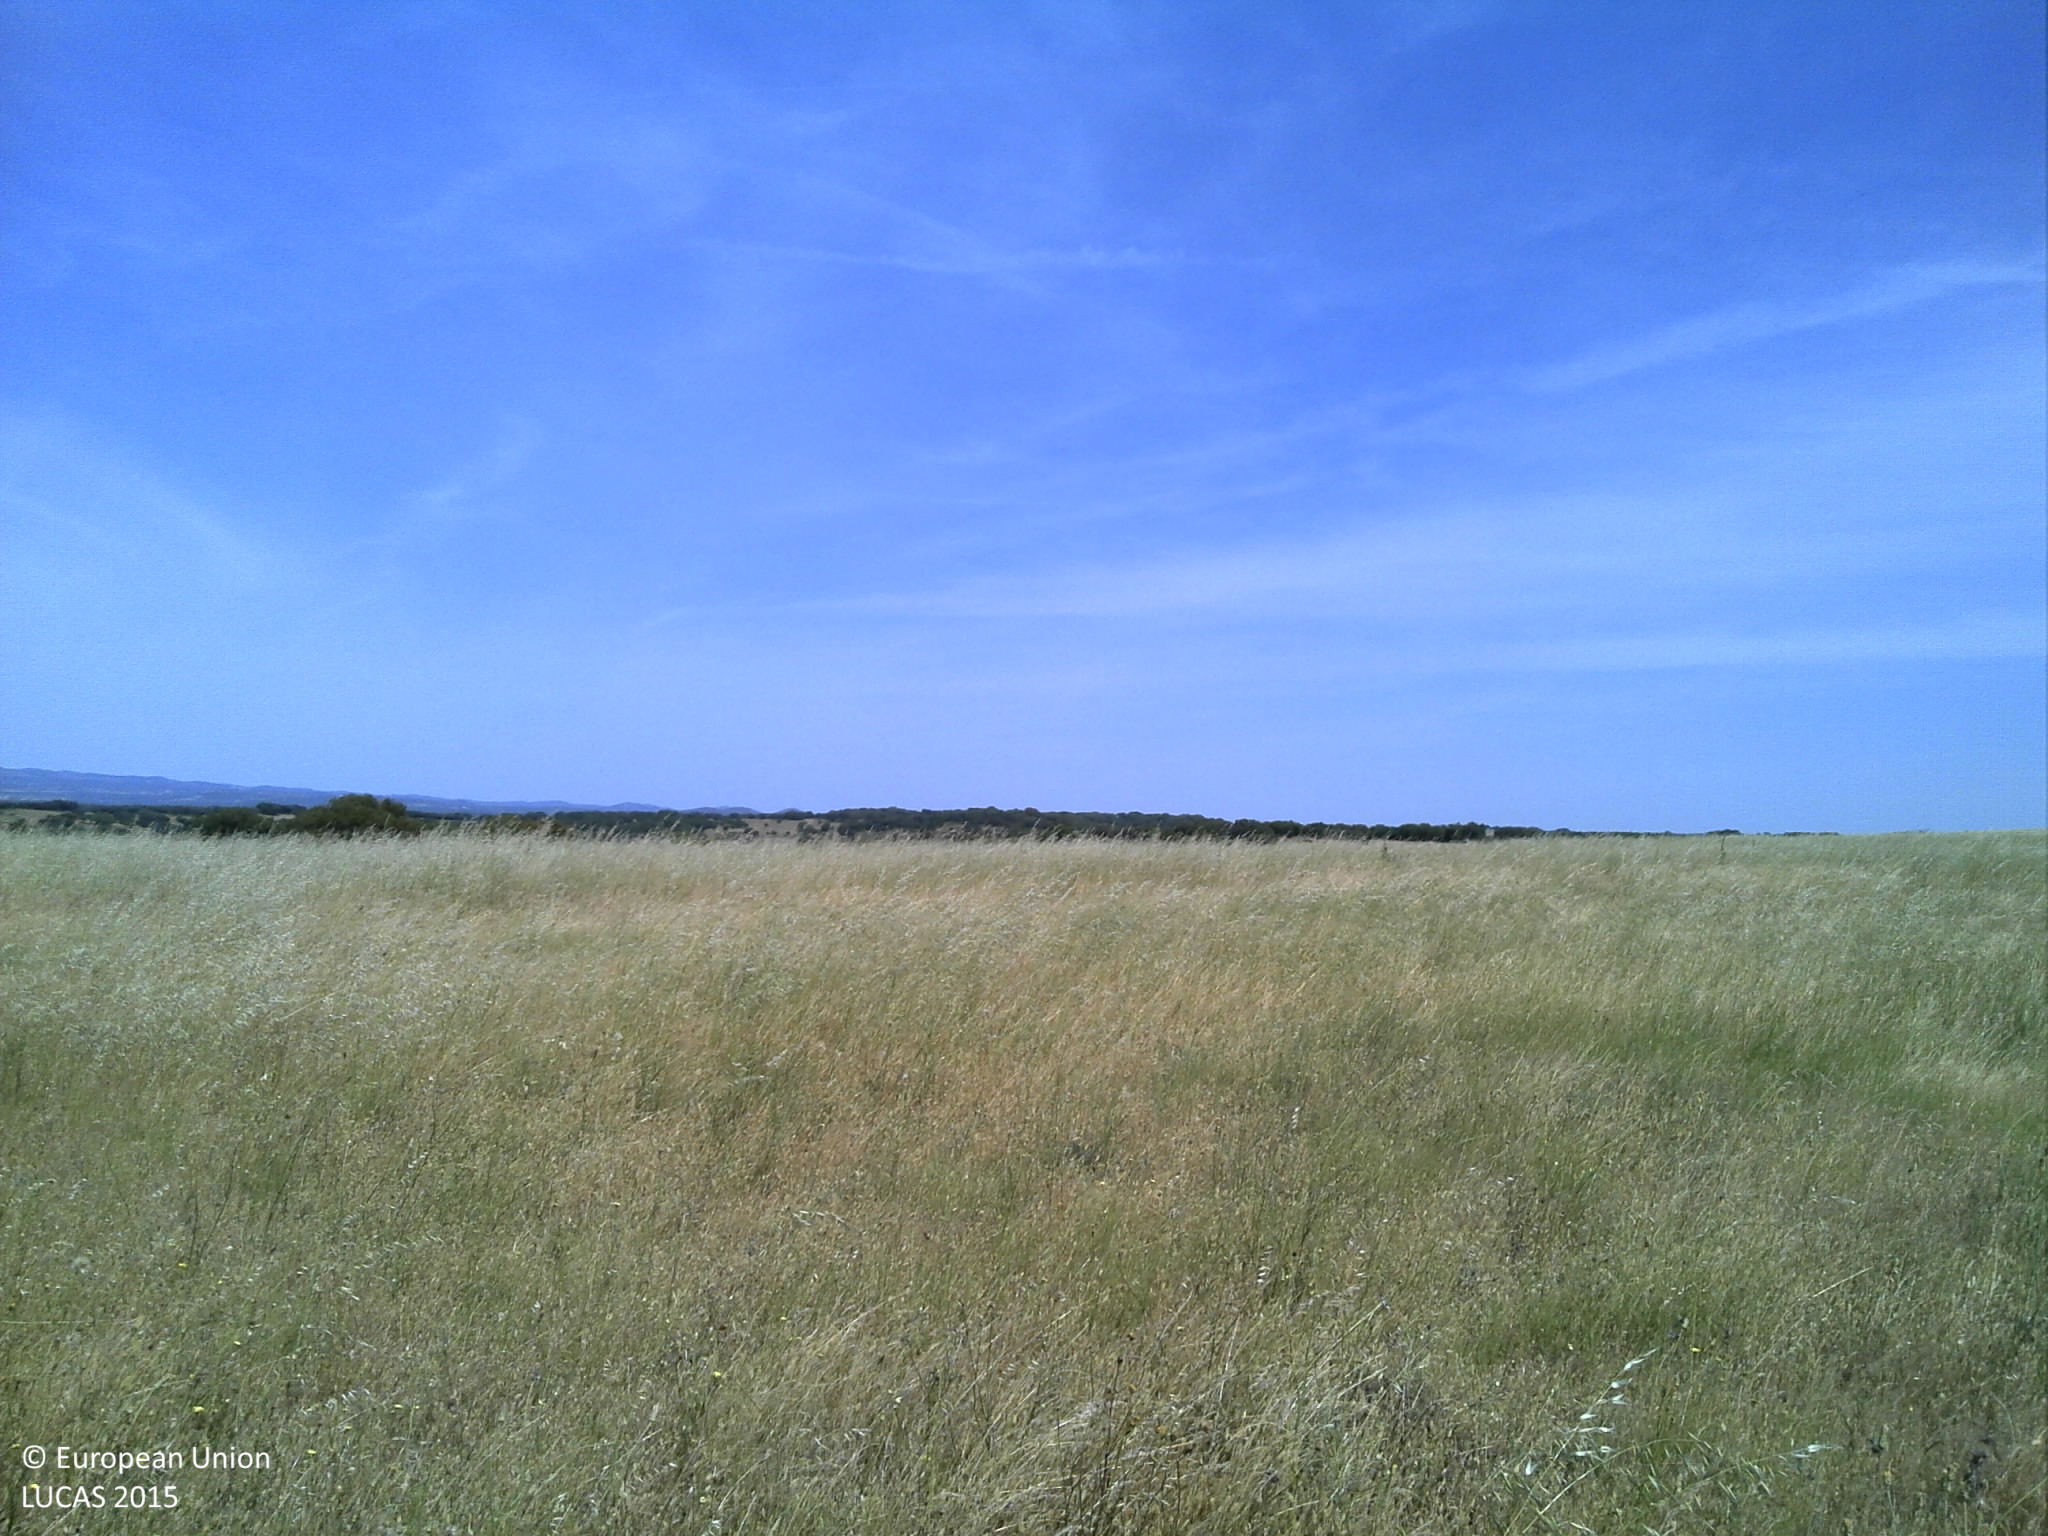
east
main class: Grassland
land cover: Grassland without tree/shrub cover
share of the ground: > 75 %
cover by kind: herbaceous plants 90 %, unconsolidated bare surface 10 %
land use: Agriculture (excluding fallow land and kitchen gardens)
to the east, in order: Grassland without tree/shrub cover
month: May
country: PT
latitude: 39.2002
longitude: -7.5862
